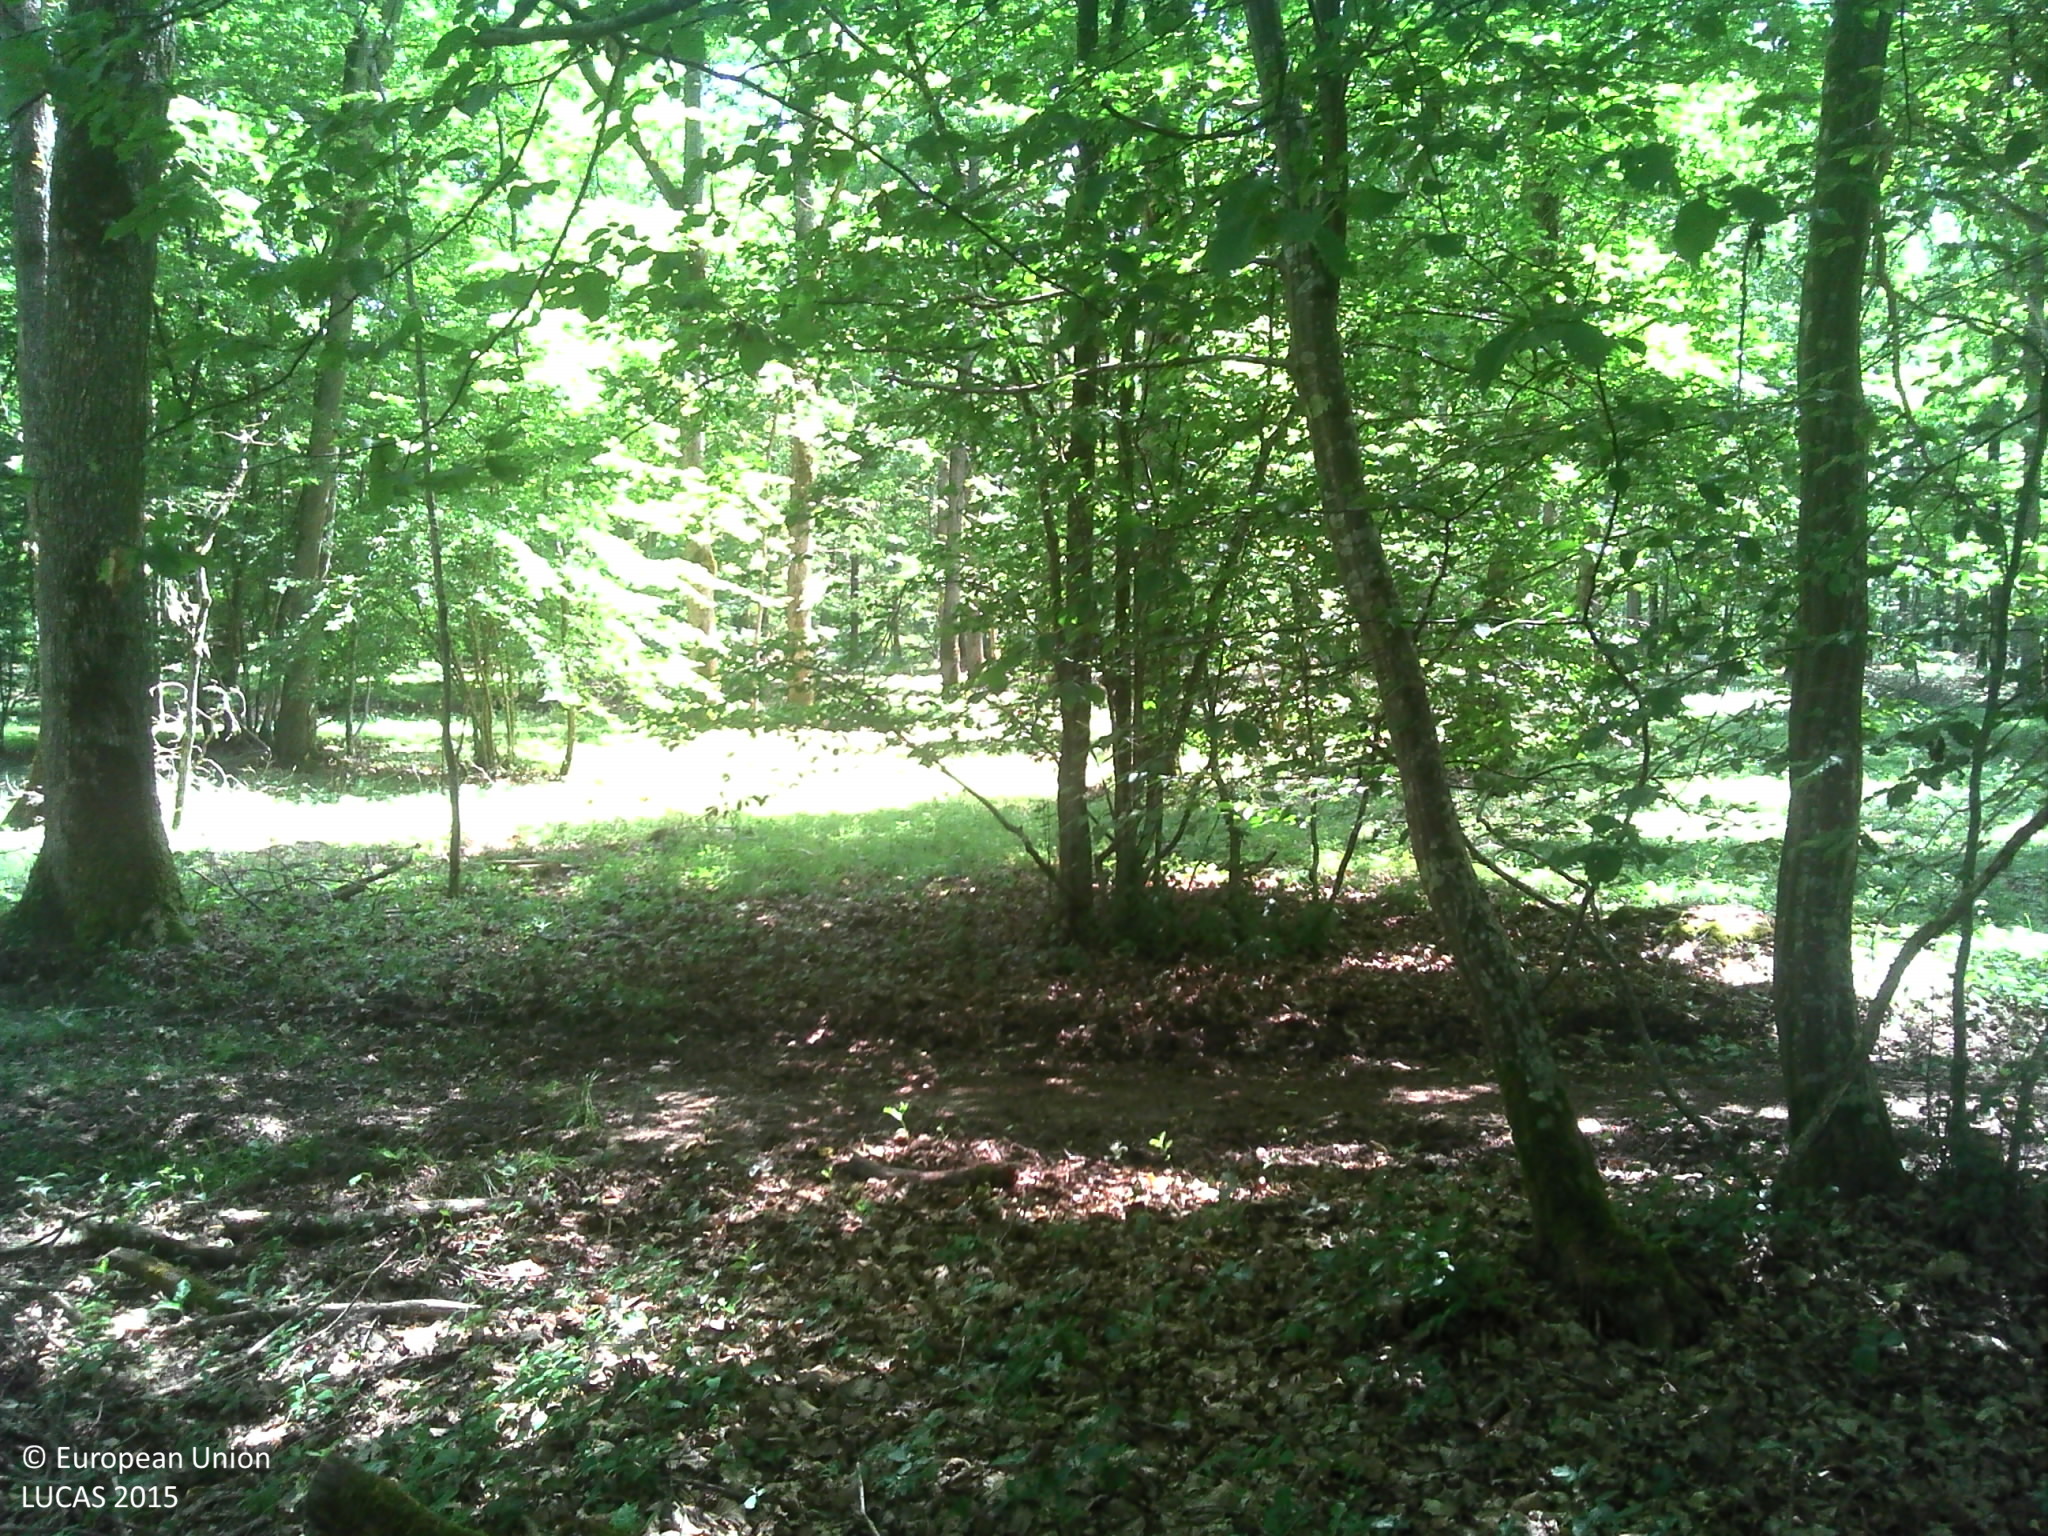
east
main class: Woodland
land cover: Broadleaved woodland
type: mesophytic deciduous forest
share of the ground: > 75 %
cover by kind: broadleaved forest trees 80 %, herbaceous plants 10 %, lichens and mosses 10 %
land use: Forestry
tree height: > 5 m
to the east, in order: Broadleaved woodland; Tracks; Broadleaved woodland; Ditches and canals; Broadleaved woodland; Ditches and canals; Broadleaved woodland; Ditches and canals; Broadleaved woodland
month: June
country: FR
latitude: 48.6156
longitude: 1.2318
